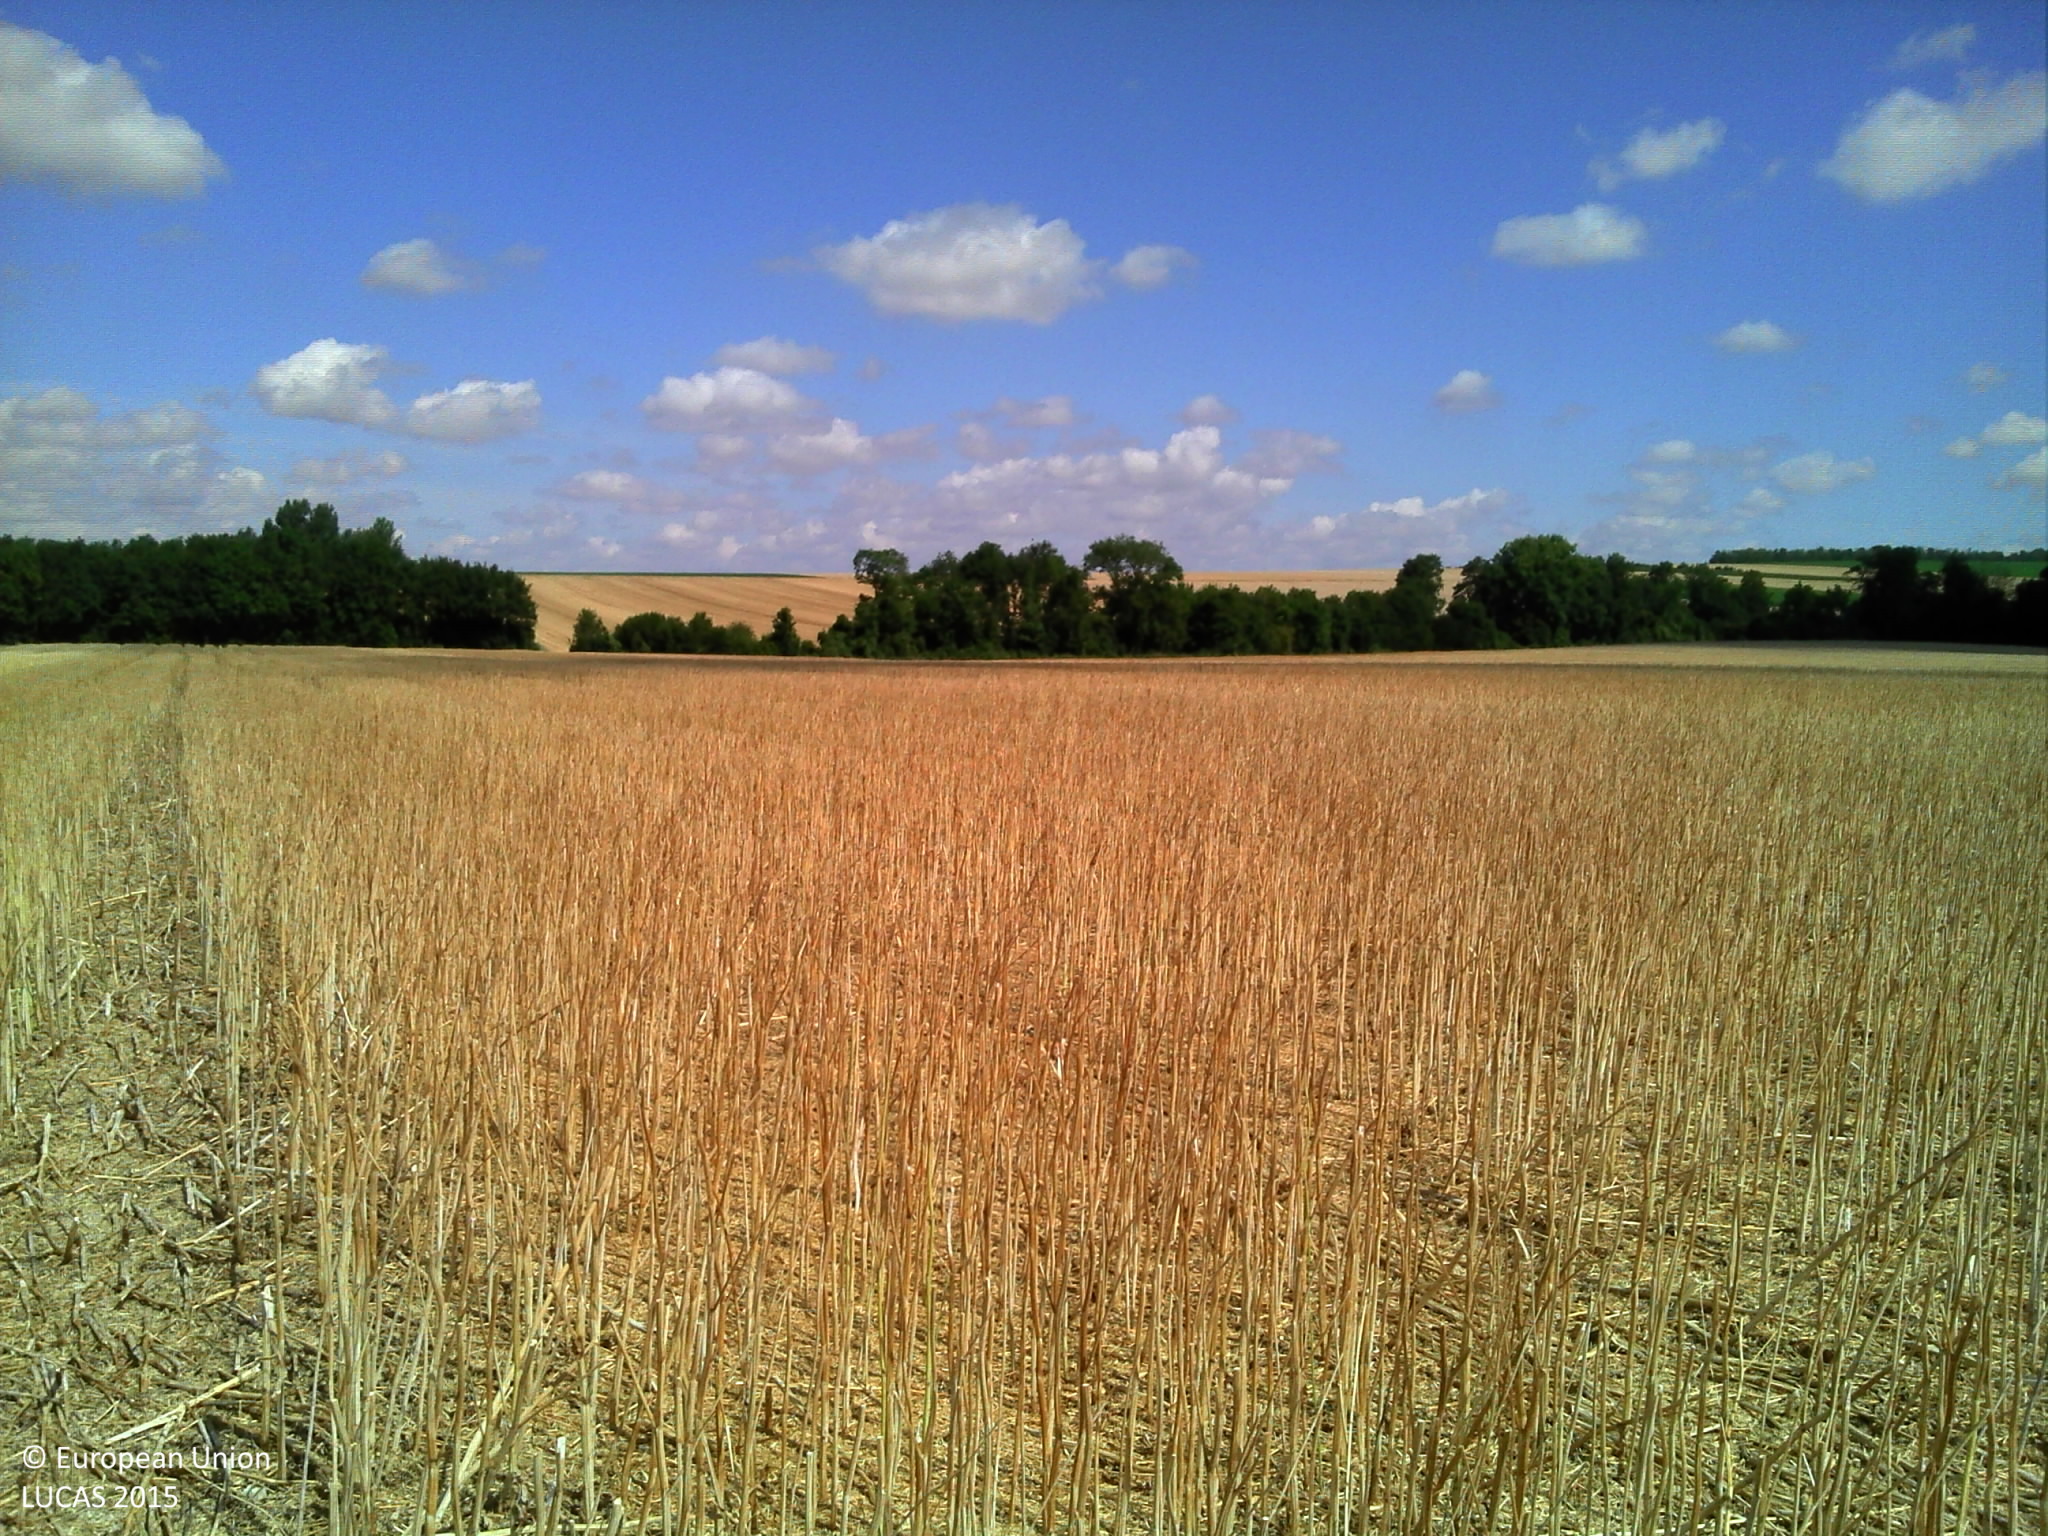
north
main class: Cropland
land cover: Rape and turnip rape
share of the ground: > 75 %
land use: Agriculture (excluding fallow land and kitchen gardens)
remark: Harvested field
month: July
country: FR
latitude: 49.3377
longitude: 4.2843
